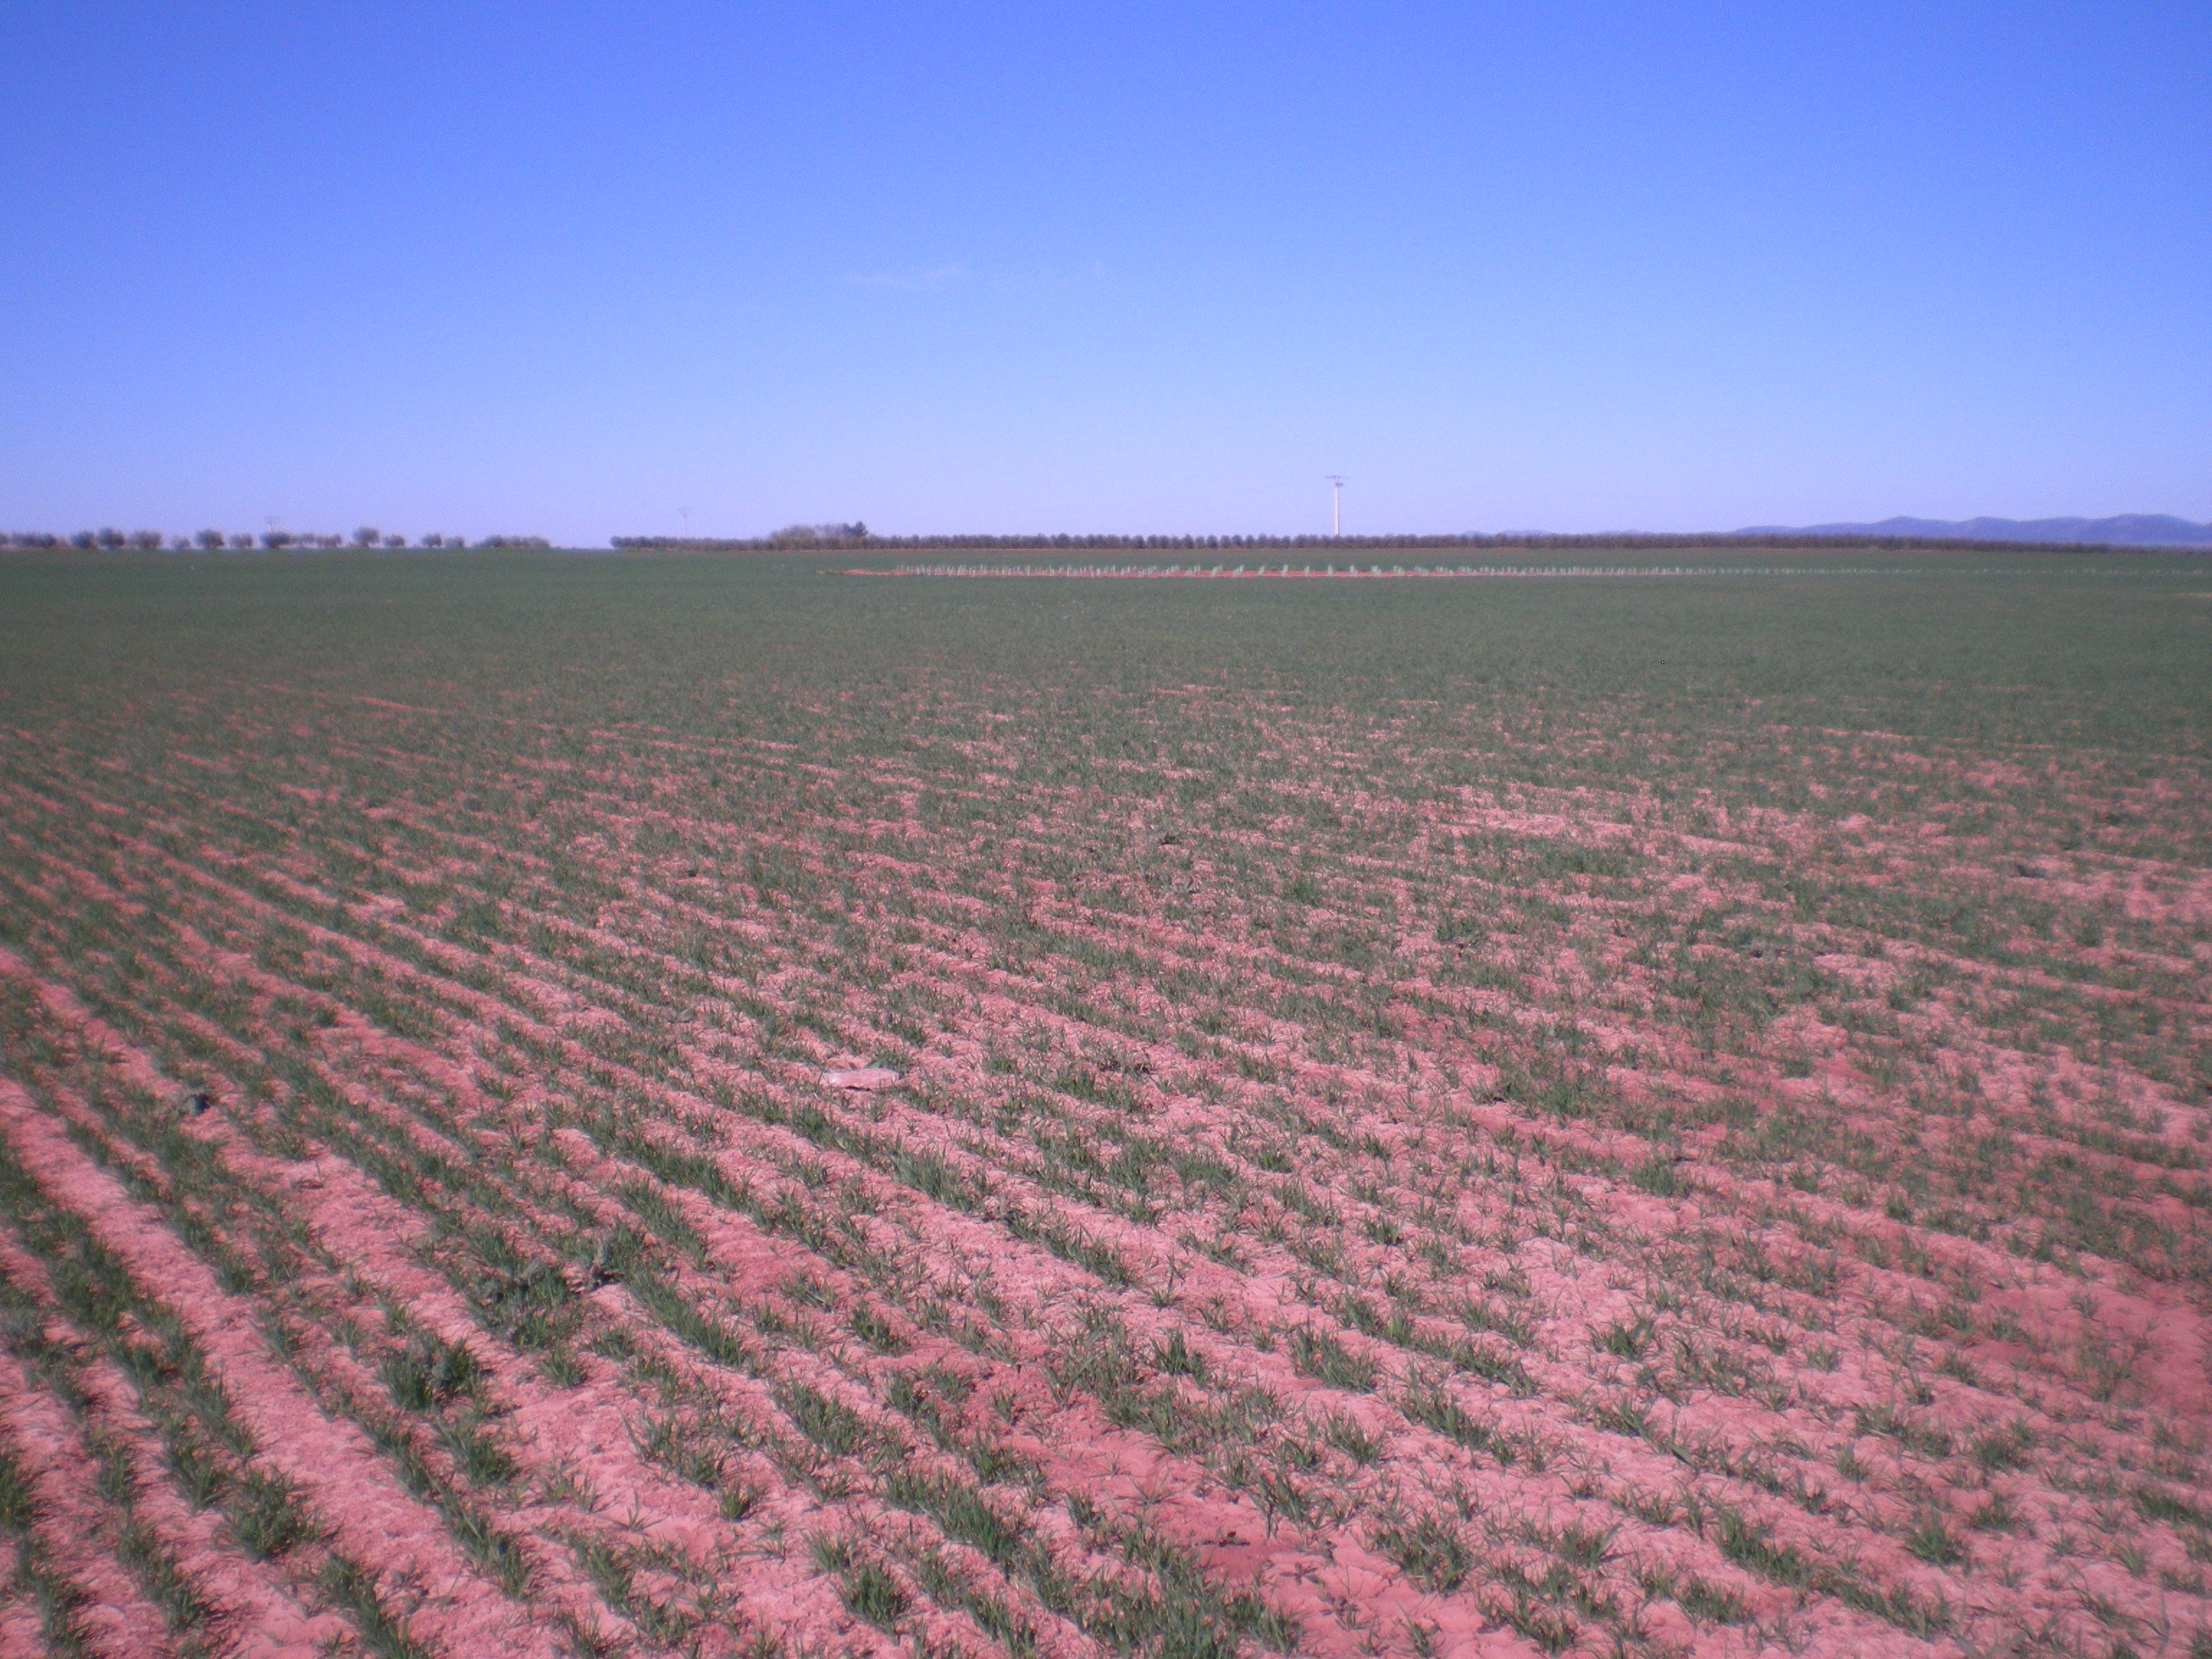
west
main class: Cropland
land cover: Barley
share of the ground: 25 - 50 %
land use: Agriculture (excluding fallow land and kitchen gardens)
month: April
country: ES
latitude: 38.7755
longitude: -3.0025
